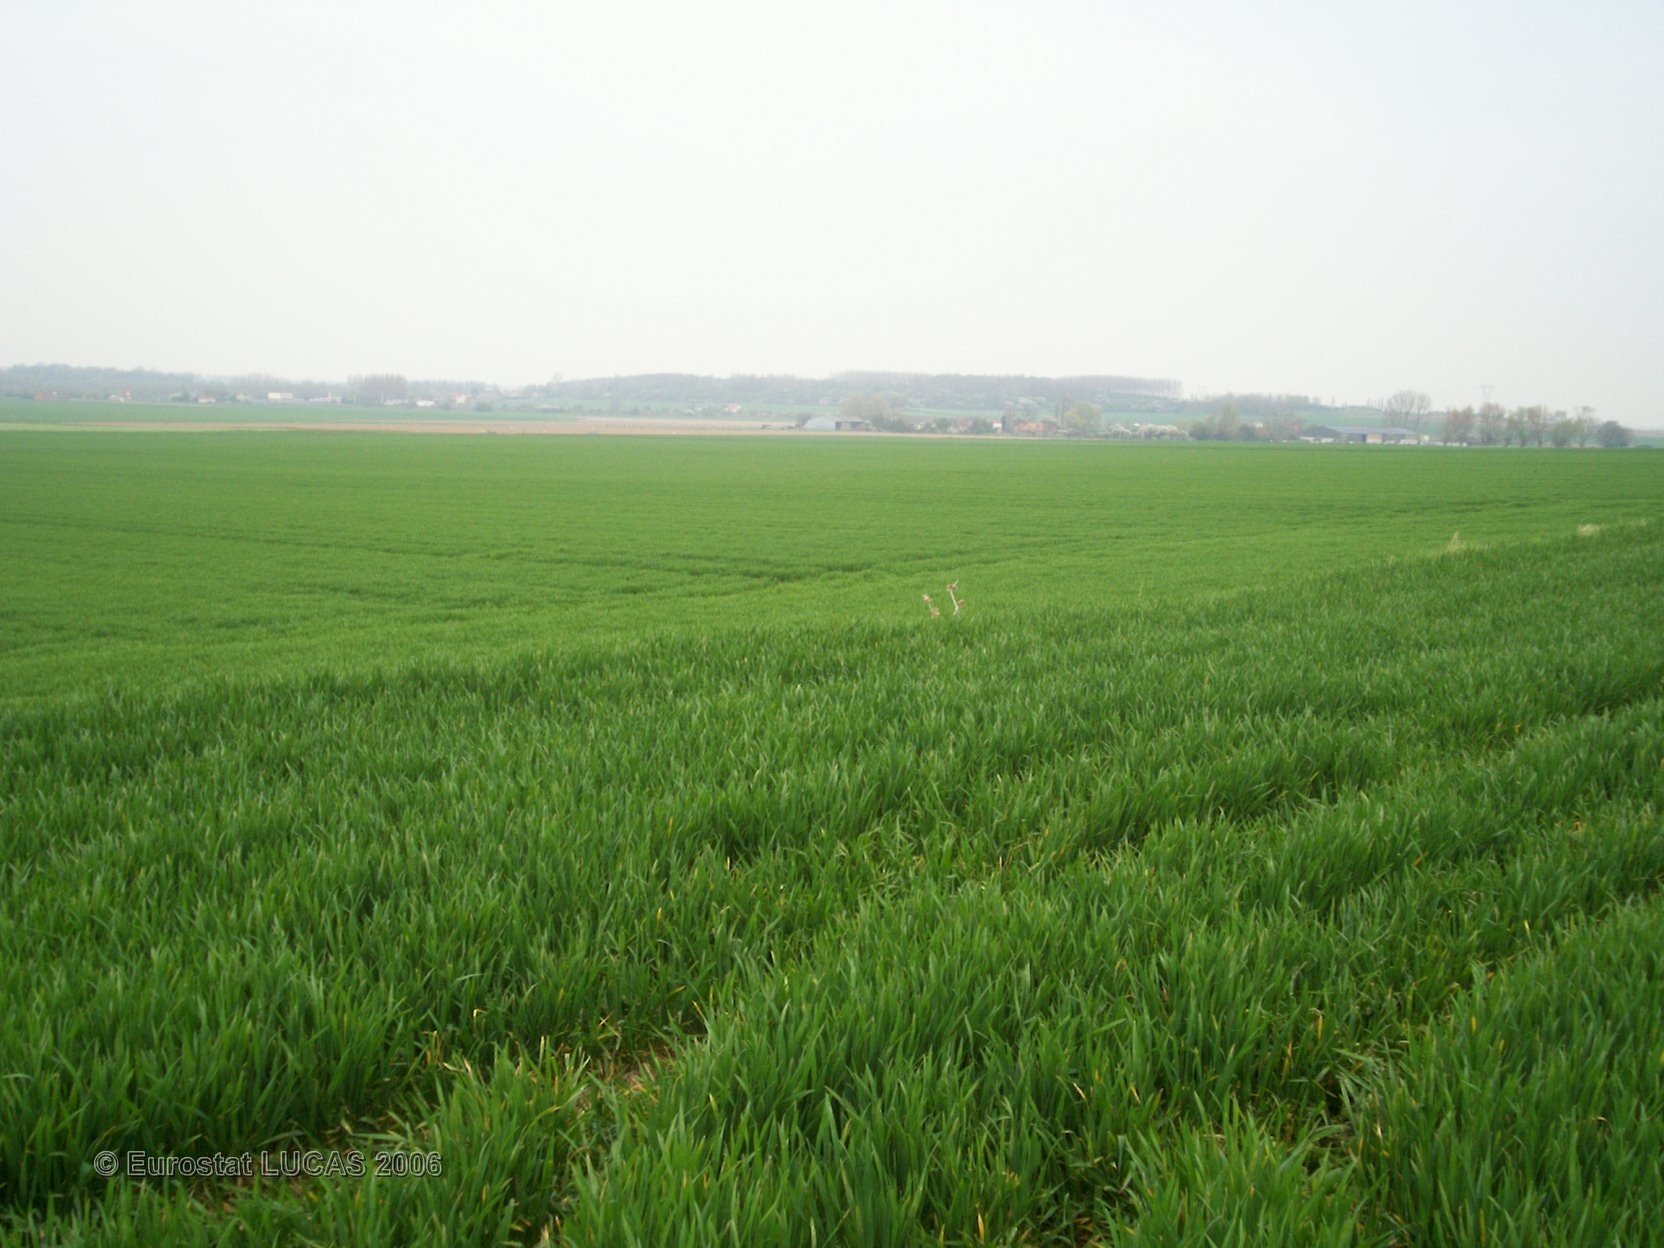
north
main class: Cropland
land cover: Common wheat
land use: Agriculture (excluding fallow land and kitchen gardens)
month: April
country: FR
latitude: 50.5204
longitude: 2.5830
